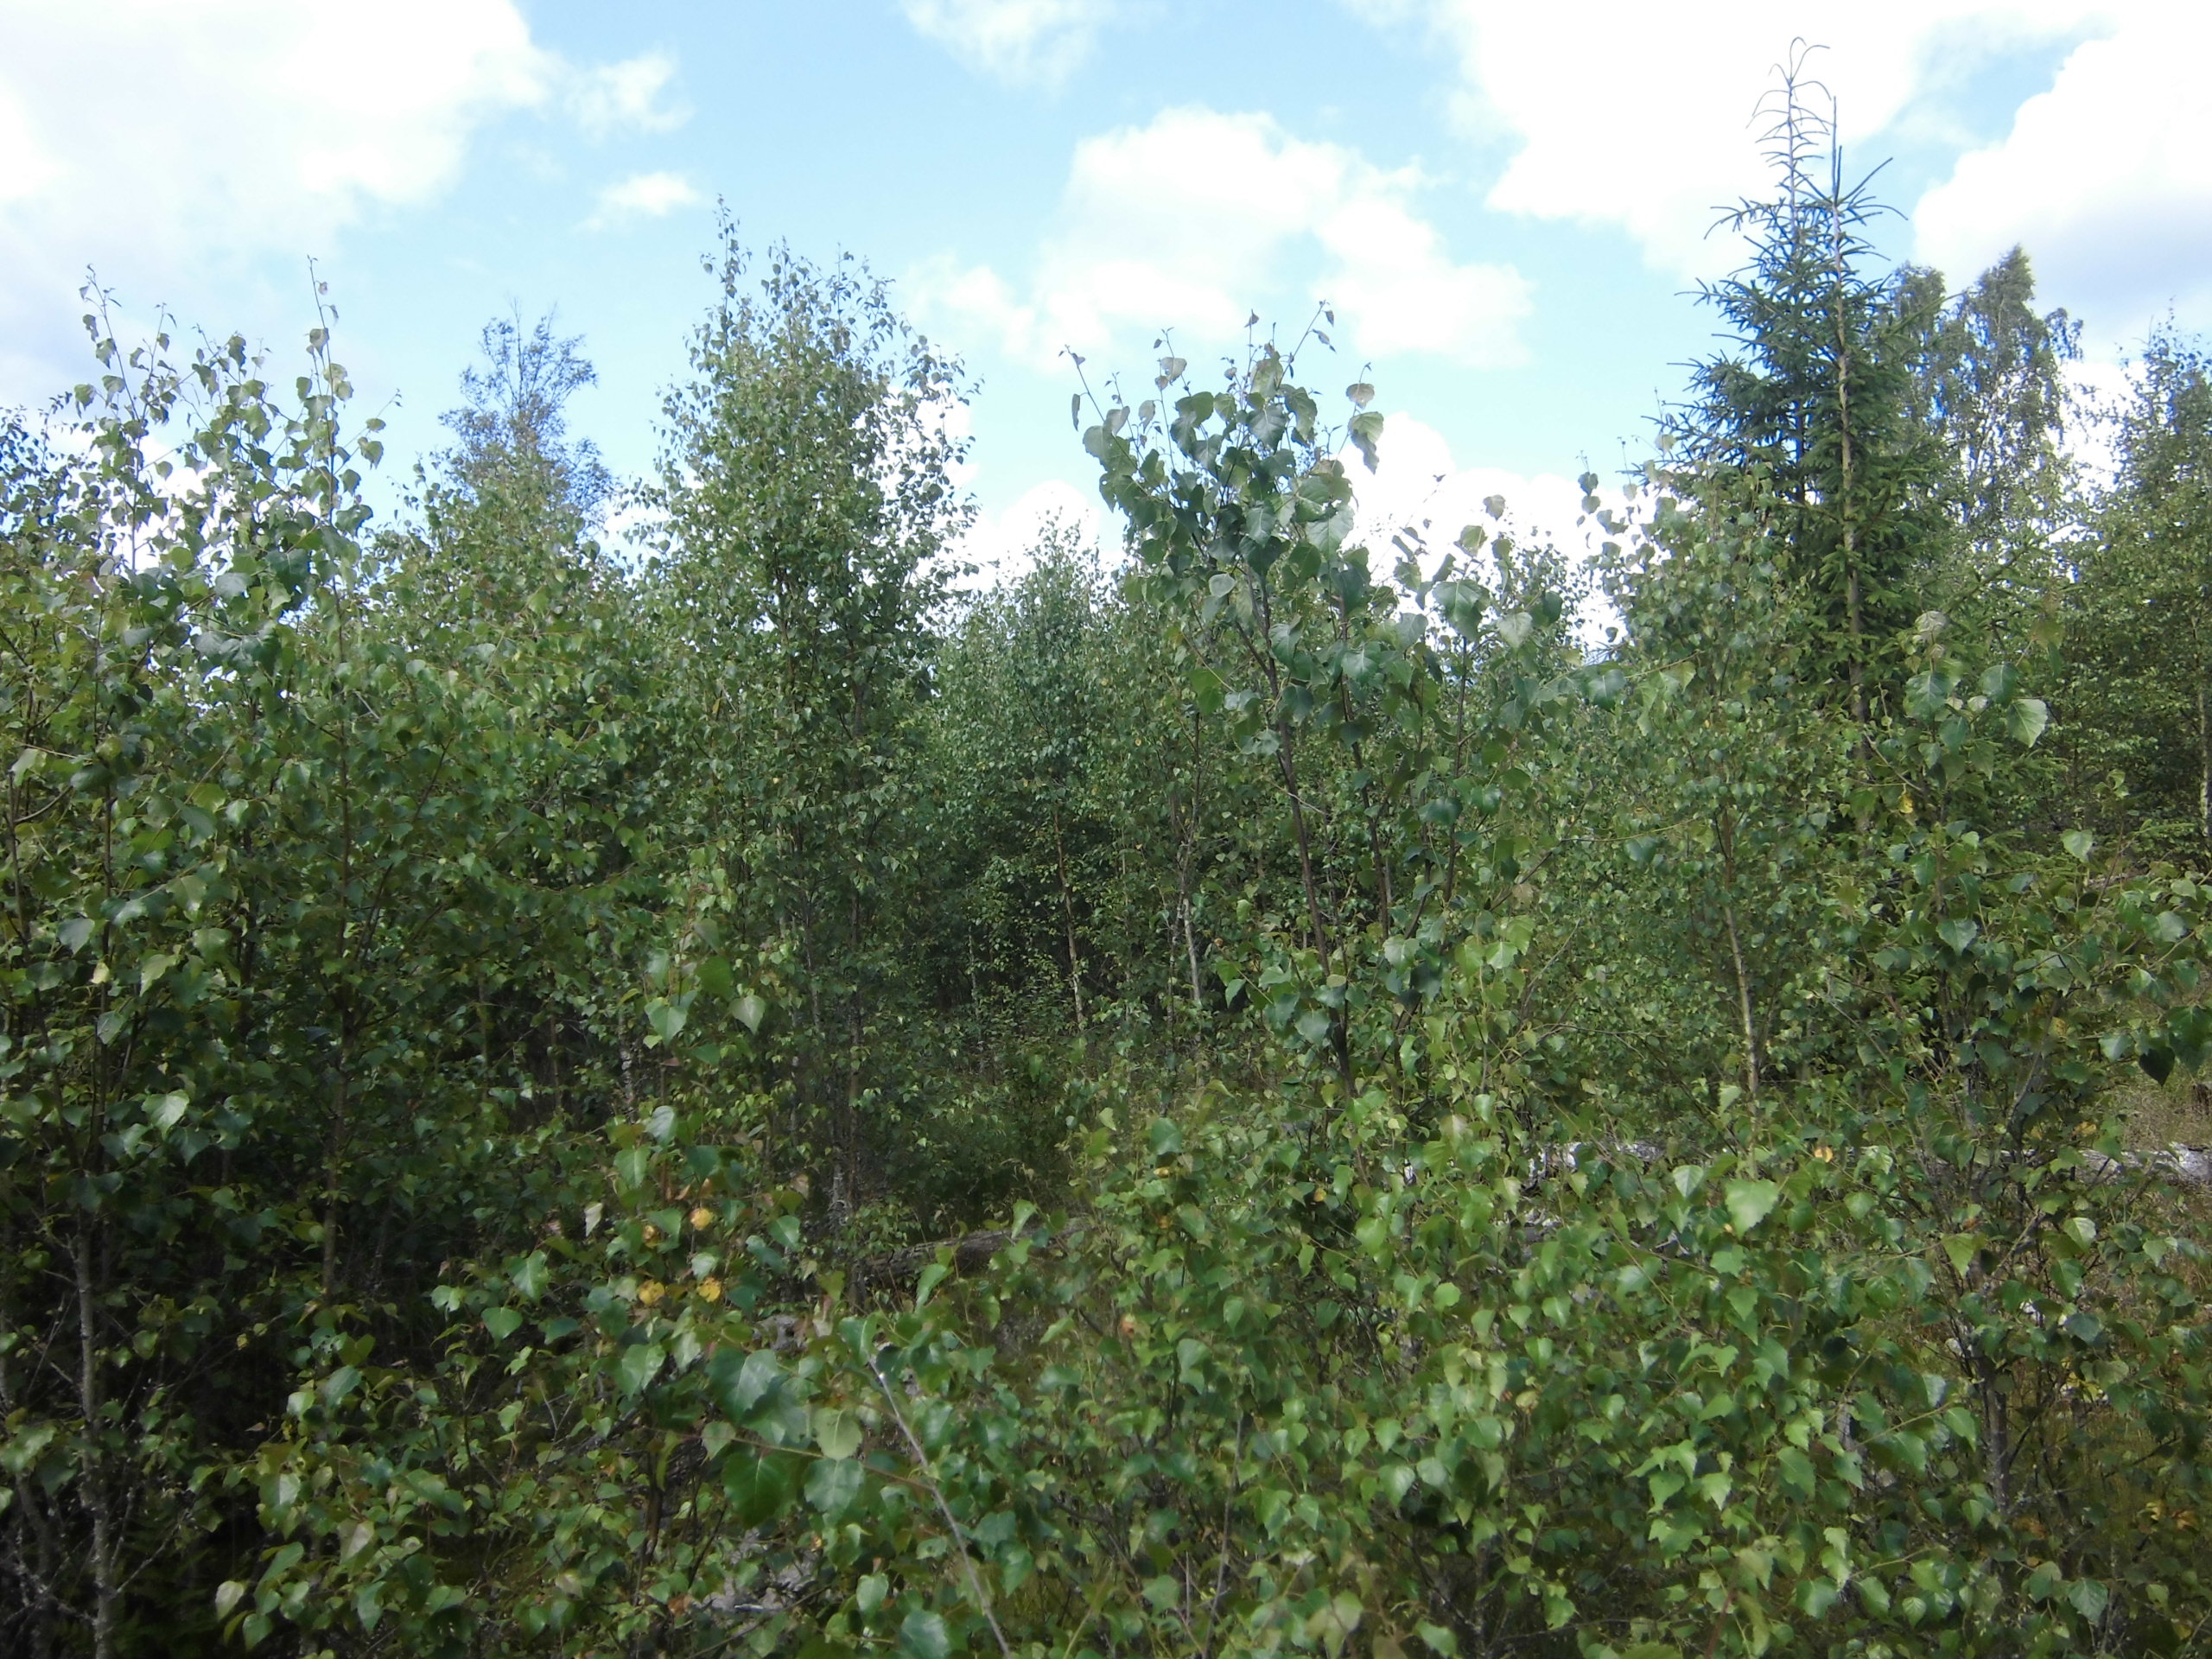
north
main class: Woodland
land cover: Broadleaved woodland
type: boreal forest
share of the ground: 50 - 75 %
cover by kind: broadleaved forest trees 55 %, herbaceous plants 20 %, shrubs 10 %, lichens and mosses 10 %, coniferous forest trees 5 %
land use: Forestry
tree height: > 5 m
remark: Clear cut
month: July
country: SE
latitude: 57.2092
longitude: 15.4110
